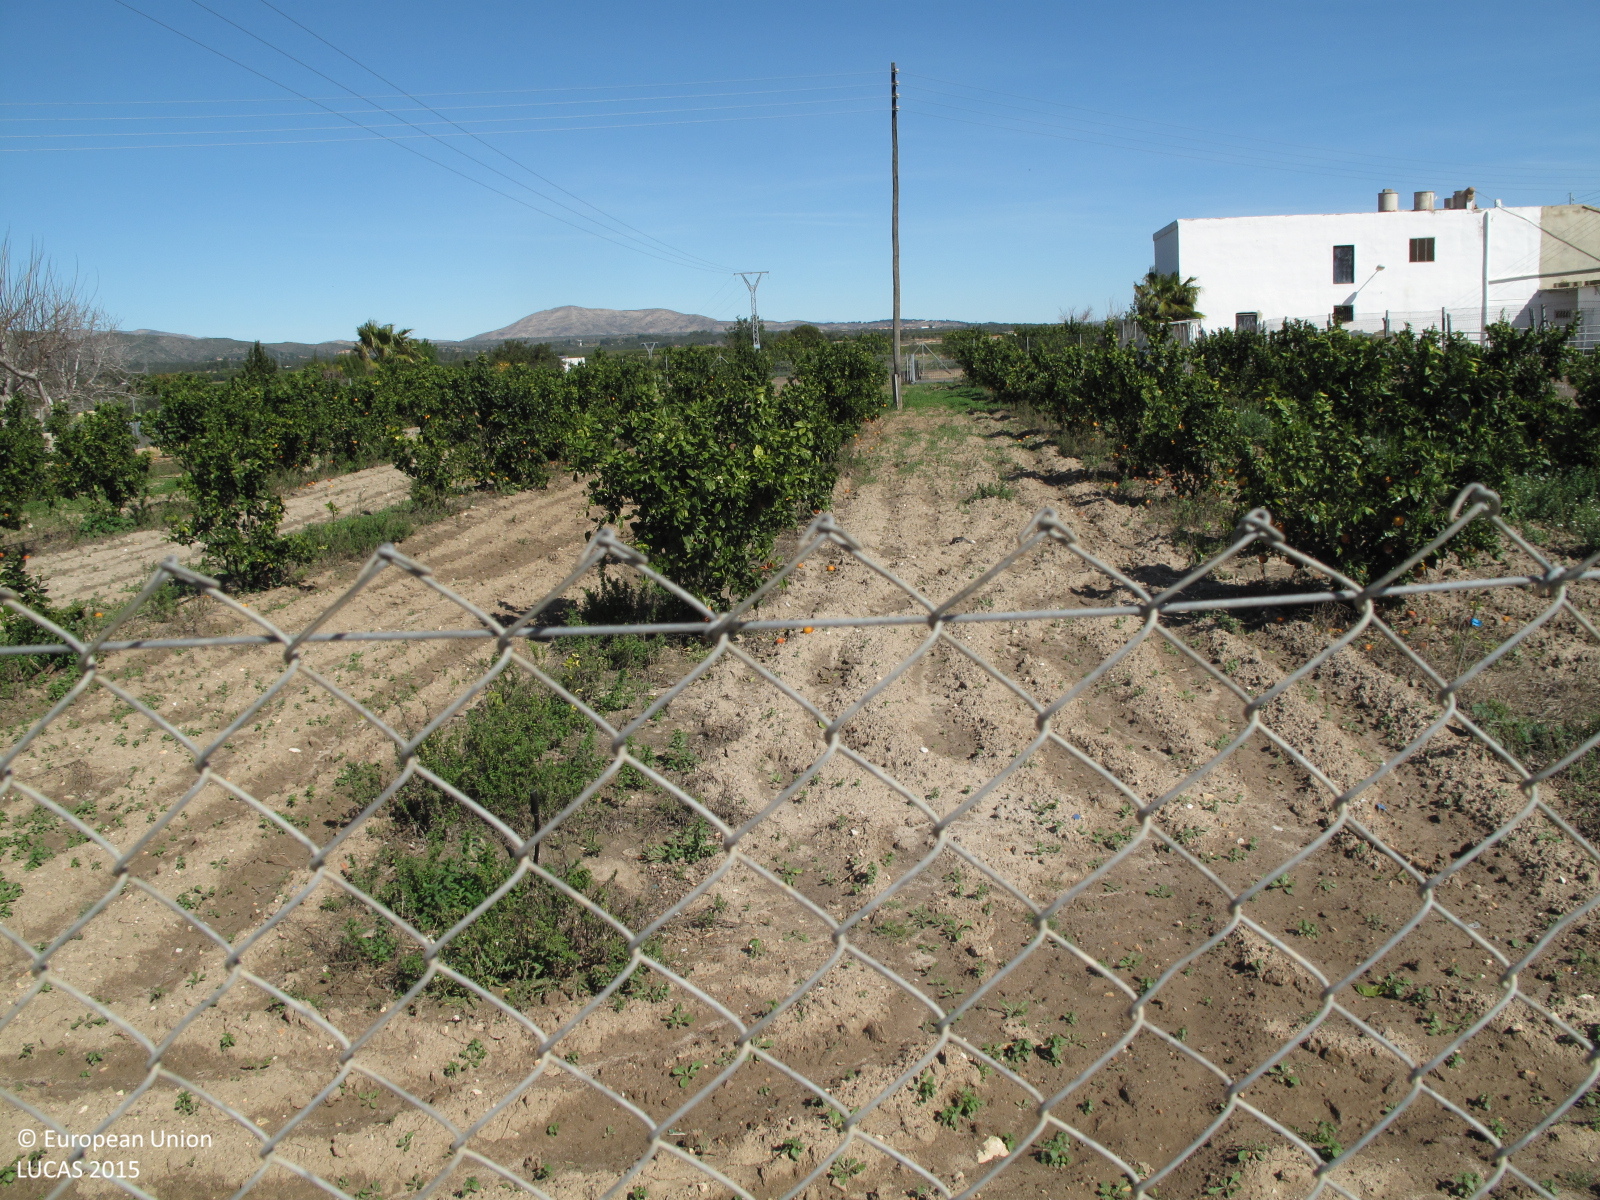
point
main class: Cropland
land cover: Oranges
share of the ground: 10 - 25 %
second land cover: Spontaneously vegetated surfaces
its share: 10 - 25 %
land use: Agriculture (excluding fallow land and kitchen gardens)
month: March
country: ES
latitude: 39.1462
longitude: -0.5818
